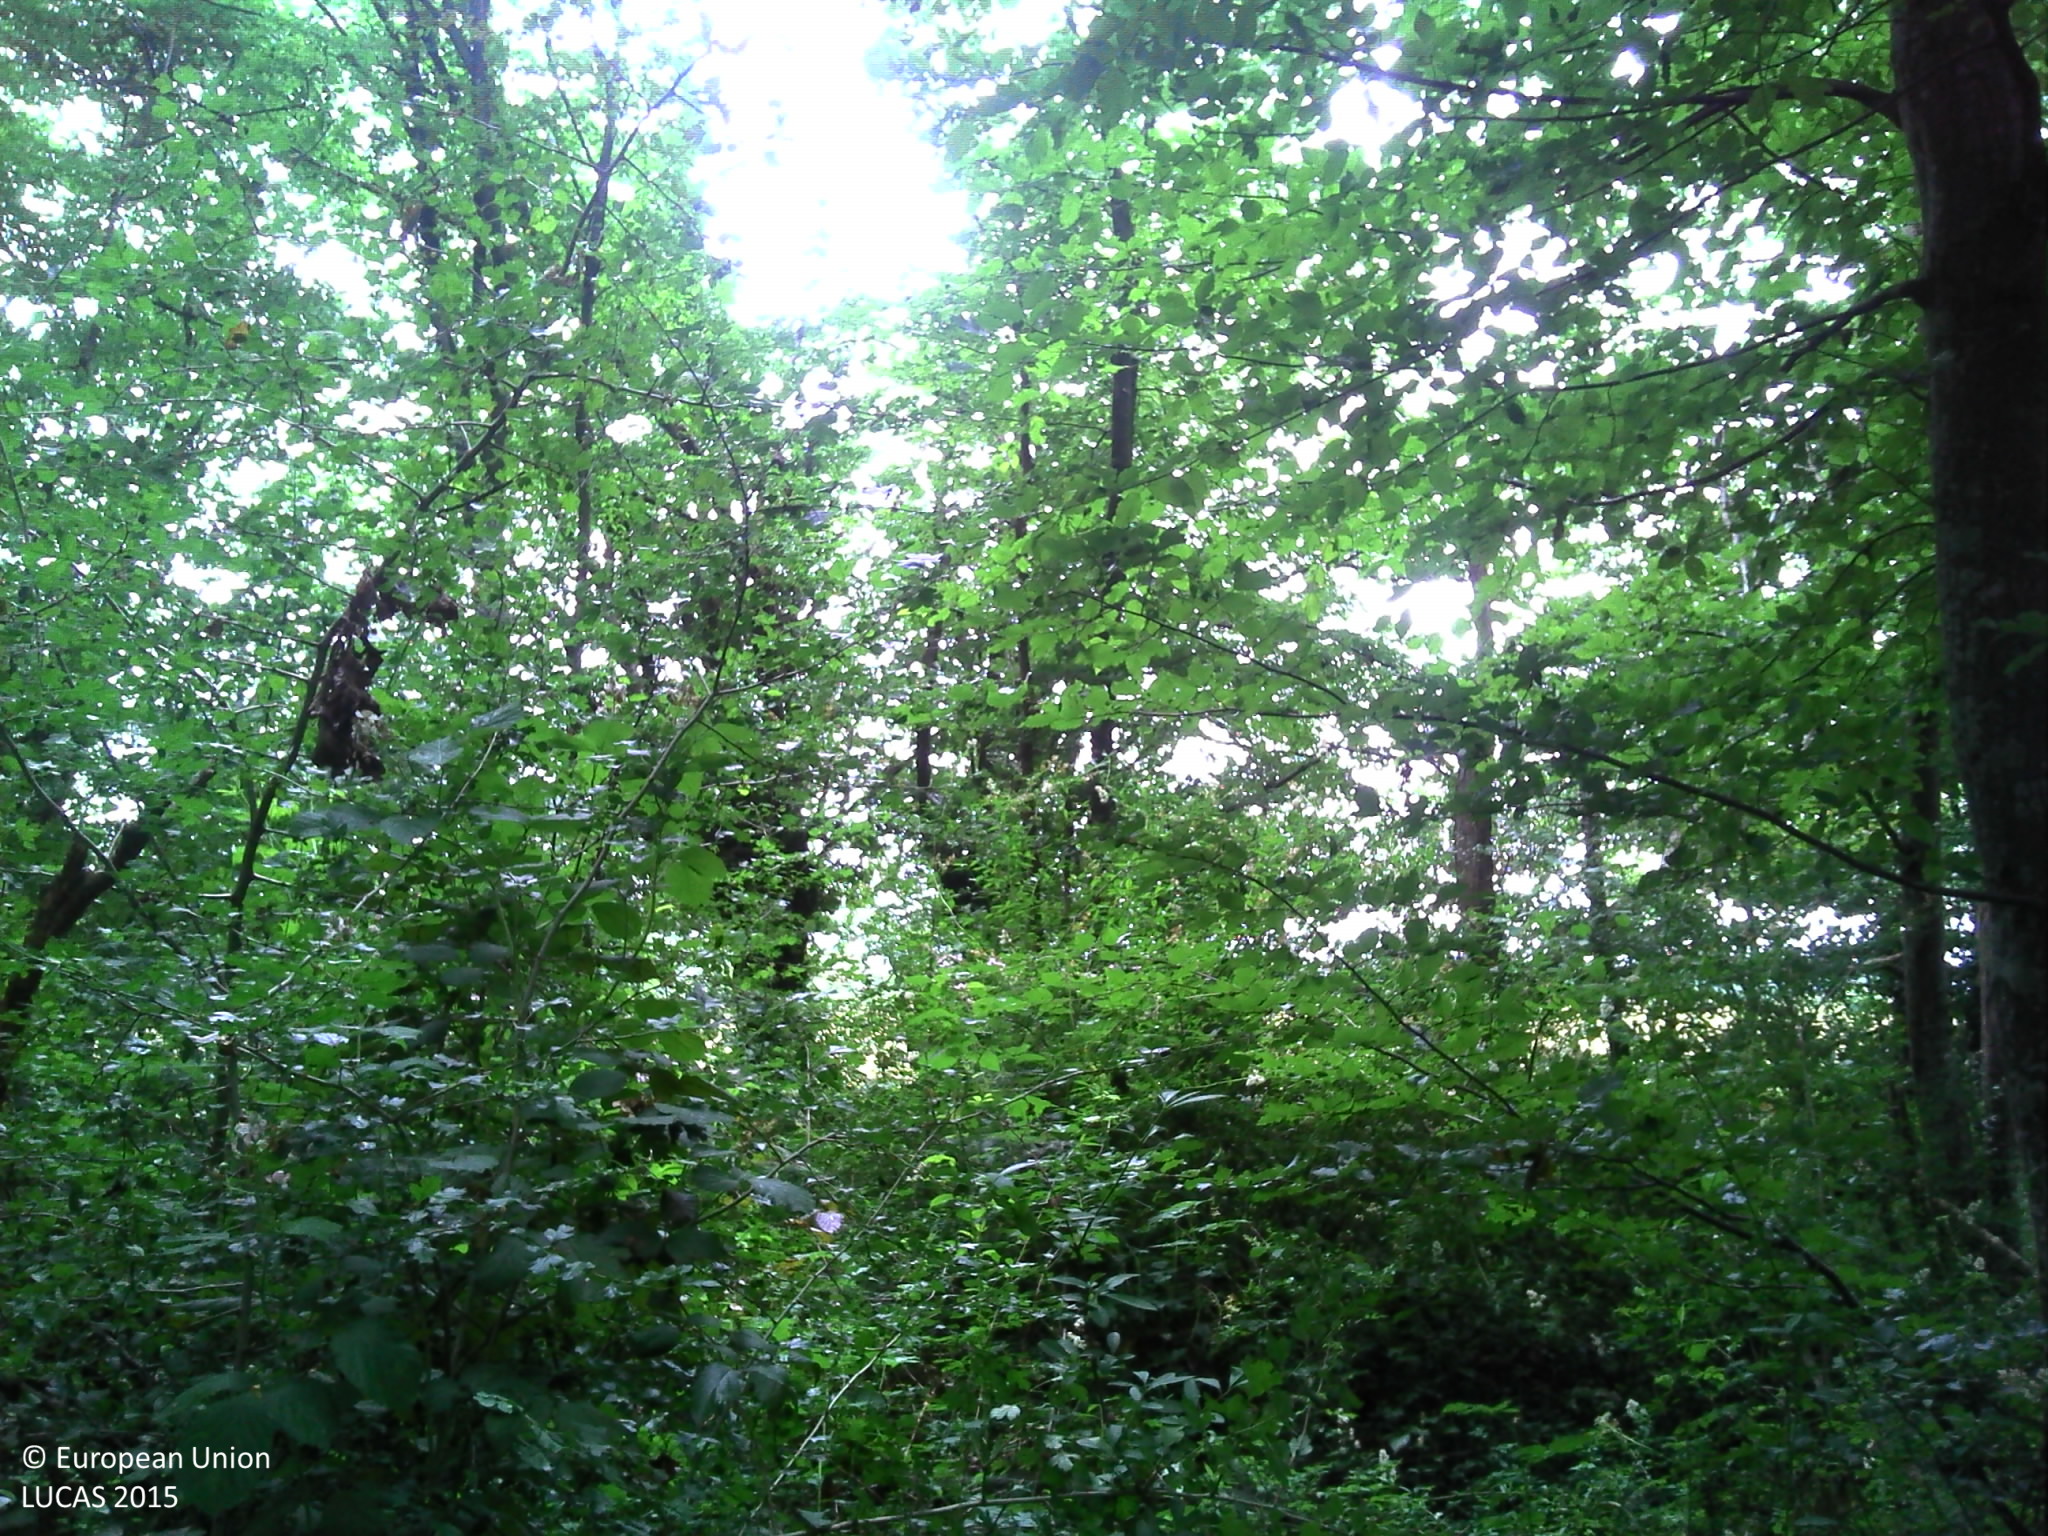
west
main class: Woodland
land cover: Broadleaved woodland
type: beech forest
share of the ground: > 75 %
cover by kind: broadleaved forest trees 65 %, herbaceous plants 20 %, shrubs 15 %
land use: Forestry
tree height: > 5 m
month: June
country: FR
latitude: 48.1177
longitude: 0.2620
